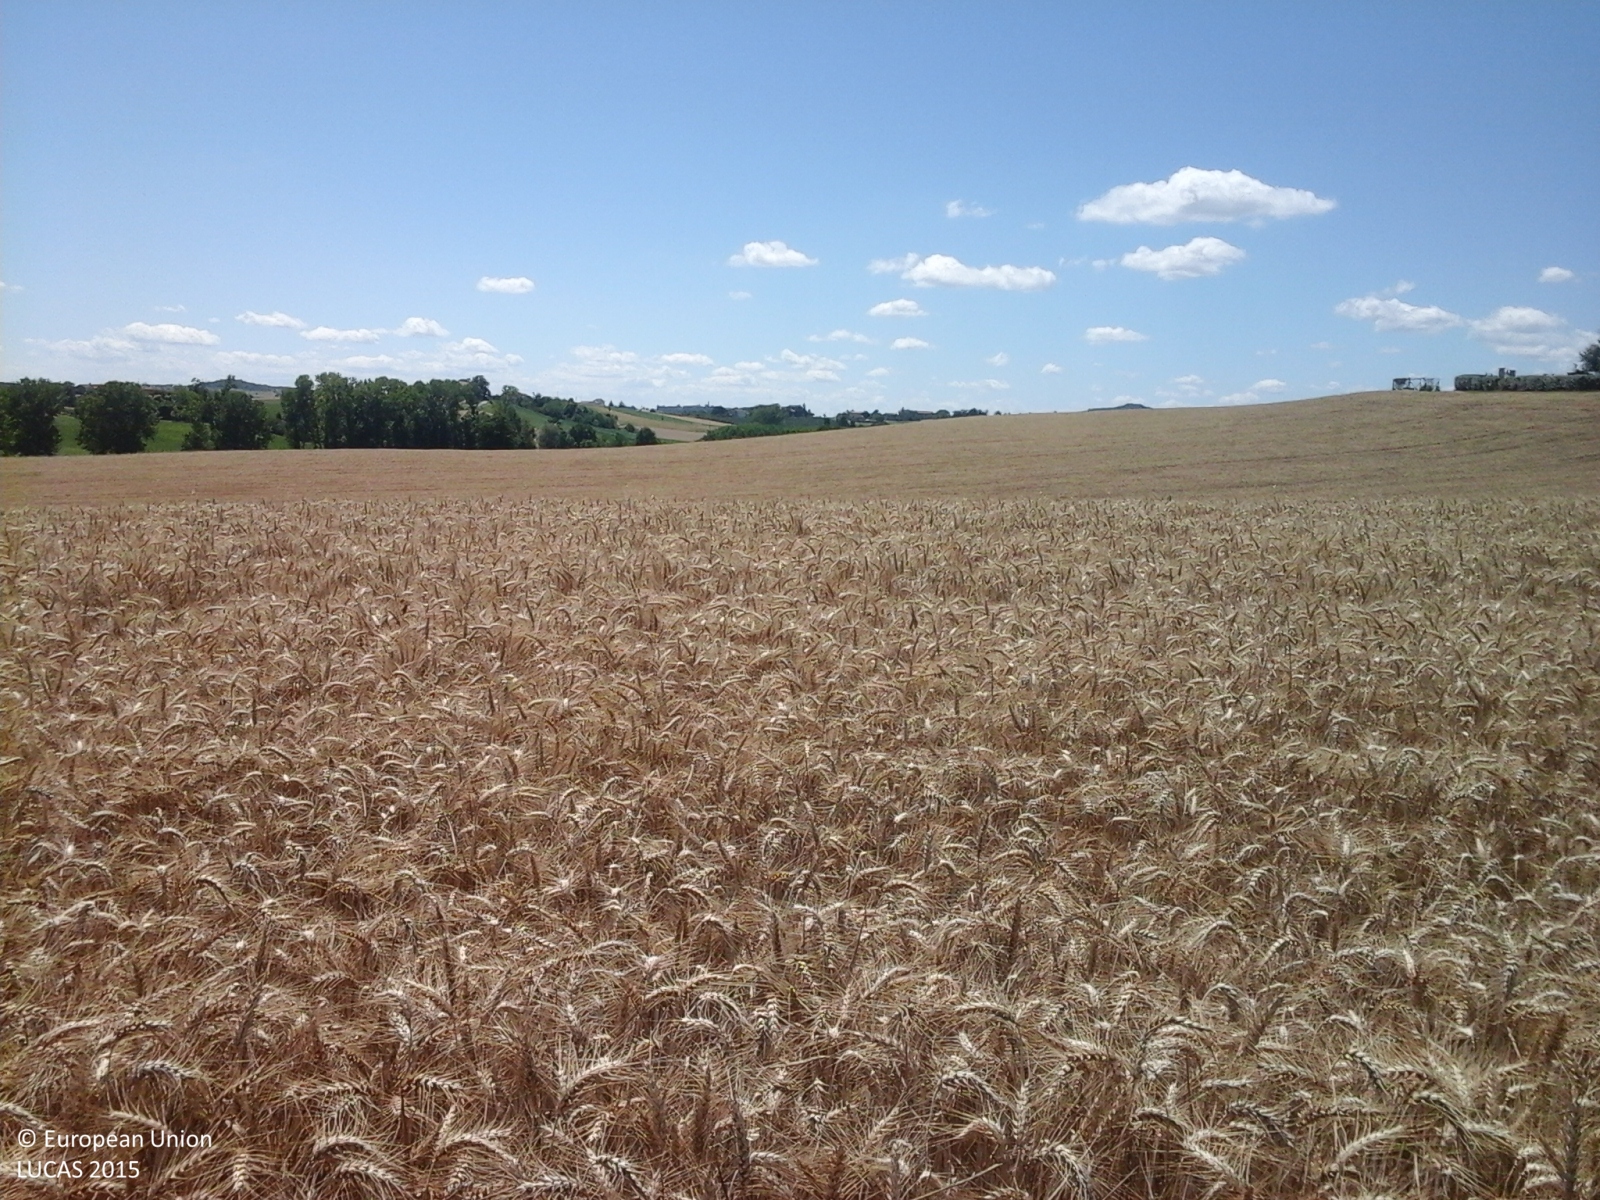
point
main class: Cropland
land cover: Common wheat
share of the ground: > 75 %
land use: Agriculture (excluding fallow land and kitchen gardens)
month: June
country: IT
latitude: 45.0602
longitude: 8.4409
